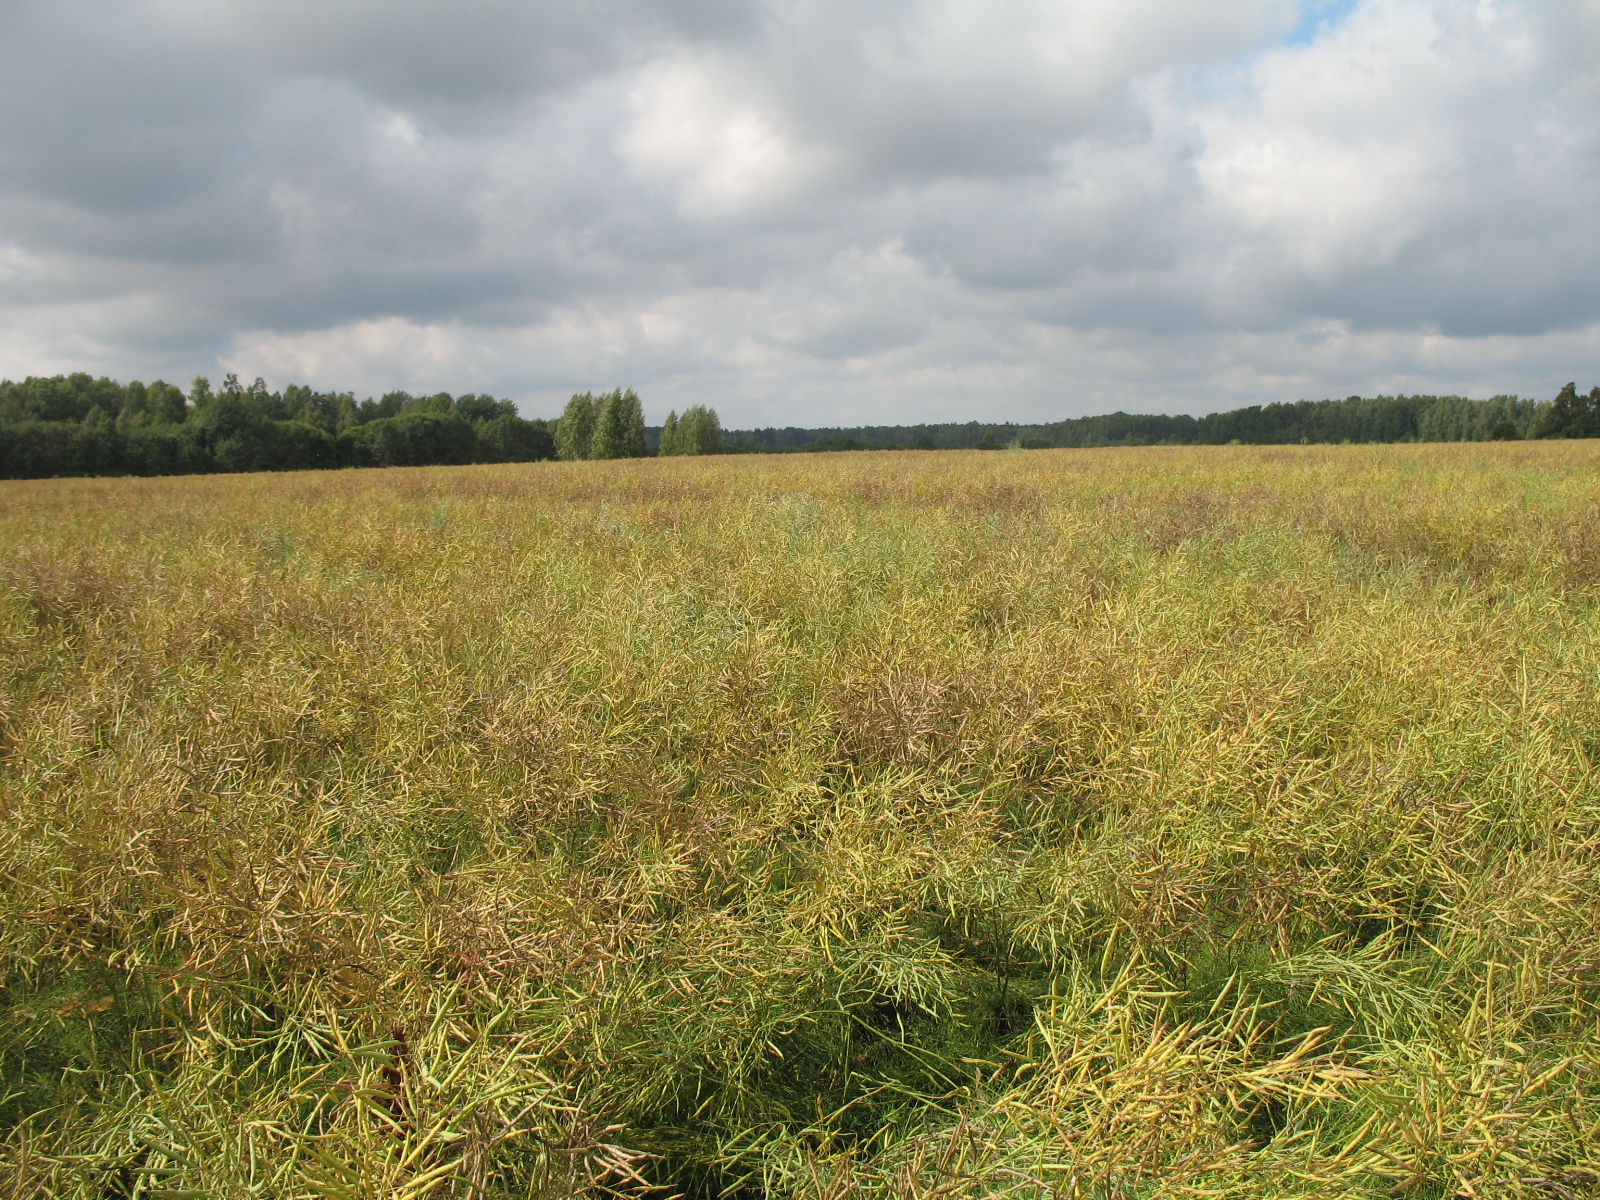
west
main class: Cropland
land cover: Rape and turnip rape
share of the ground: > 75 %
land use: Agriculture (excluding fallow land and kitchen gardens)
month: September
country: LV
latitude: 56.1746
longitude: 25.9347
